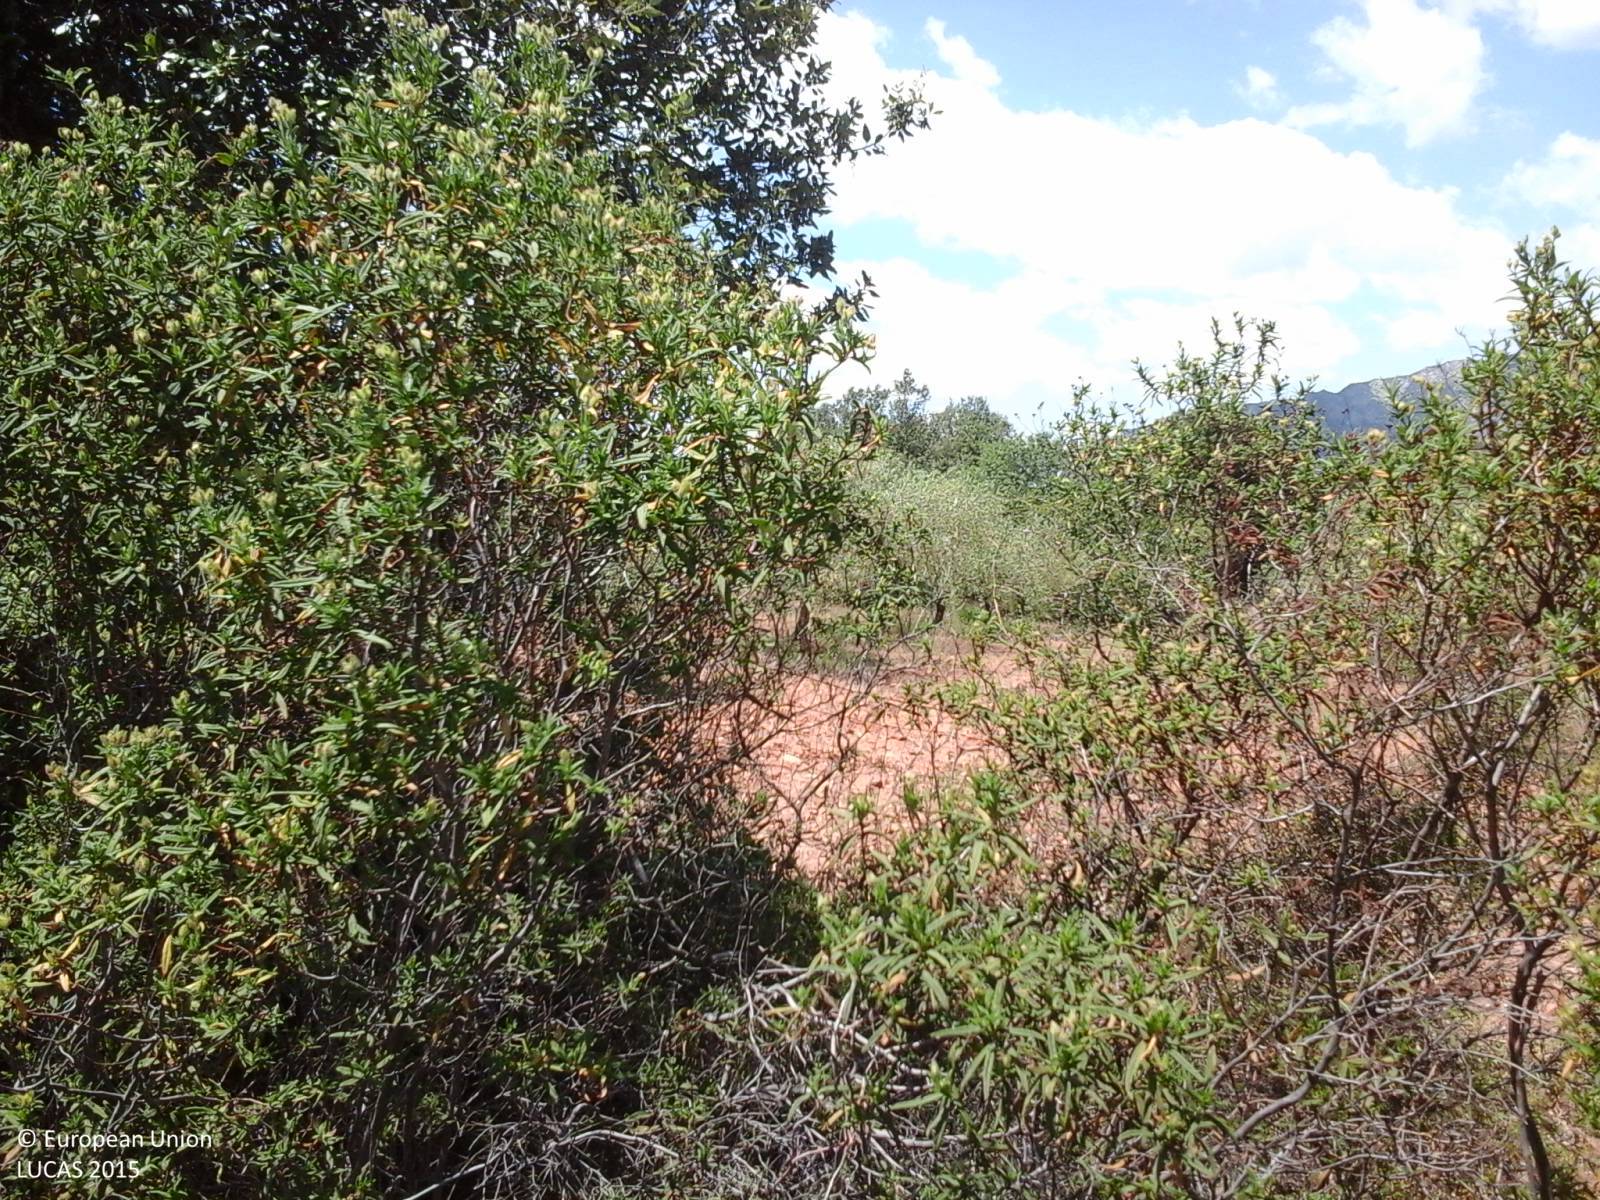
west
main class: Shrubland
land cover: Shrubland without tree cover
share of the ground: > 75 %
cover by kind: shrubs 95 %, unconsolidated bare surface 5 %
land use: Semi-natural and natural areas not in use
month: May
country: IT
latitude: 40.2838
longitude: 9.4267
